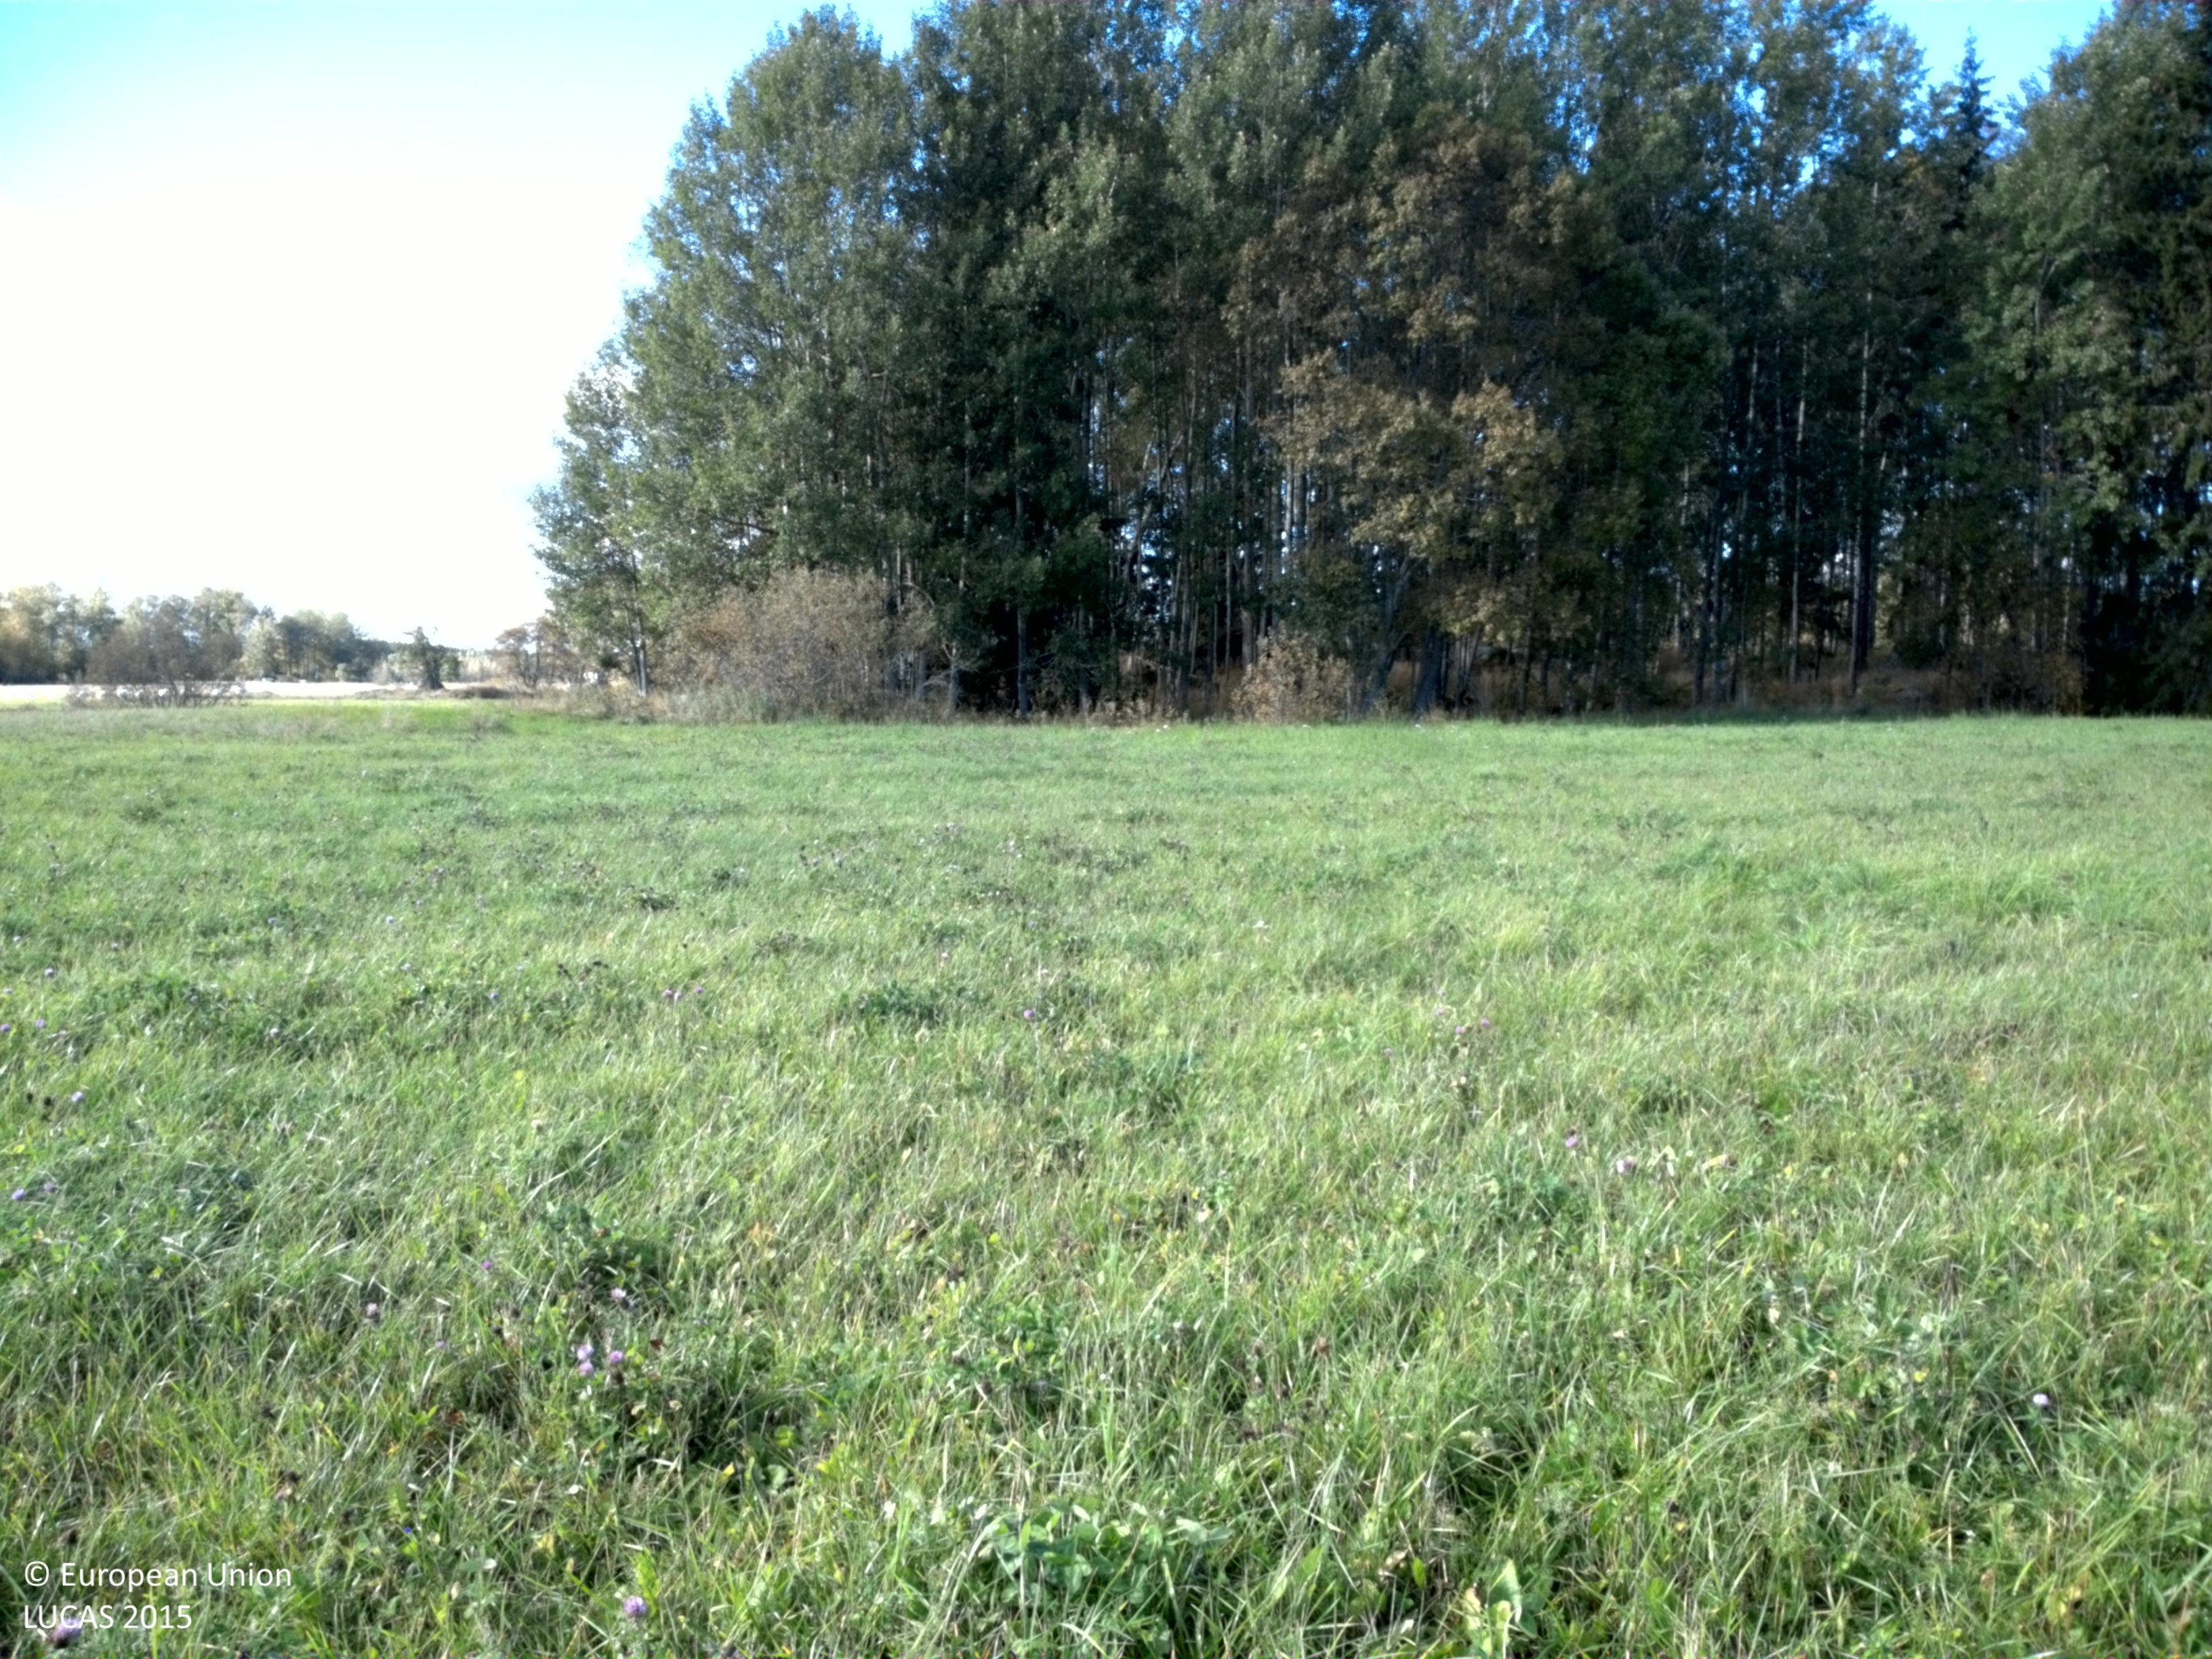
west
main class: Cropland
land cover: Other leguminous and mixtures for fodder
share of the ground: < 10 %
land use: Agriculture (excluding fallow land and kitchen gardens)
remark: Harvested field
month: September
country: SE
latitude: 60.0843
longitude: 16.5155
